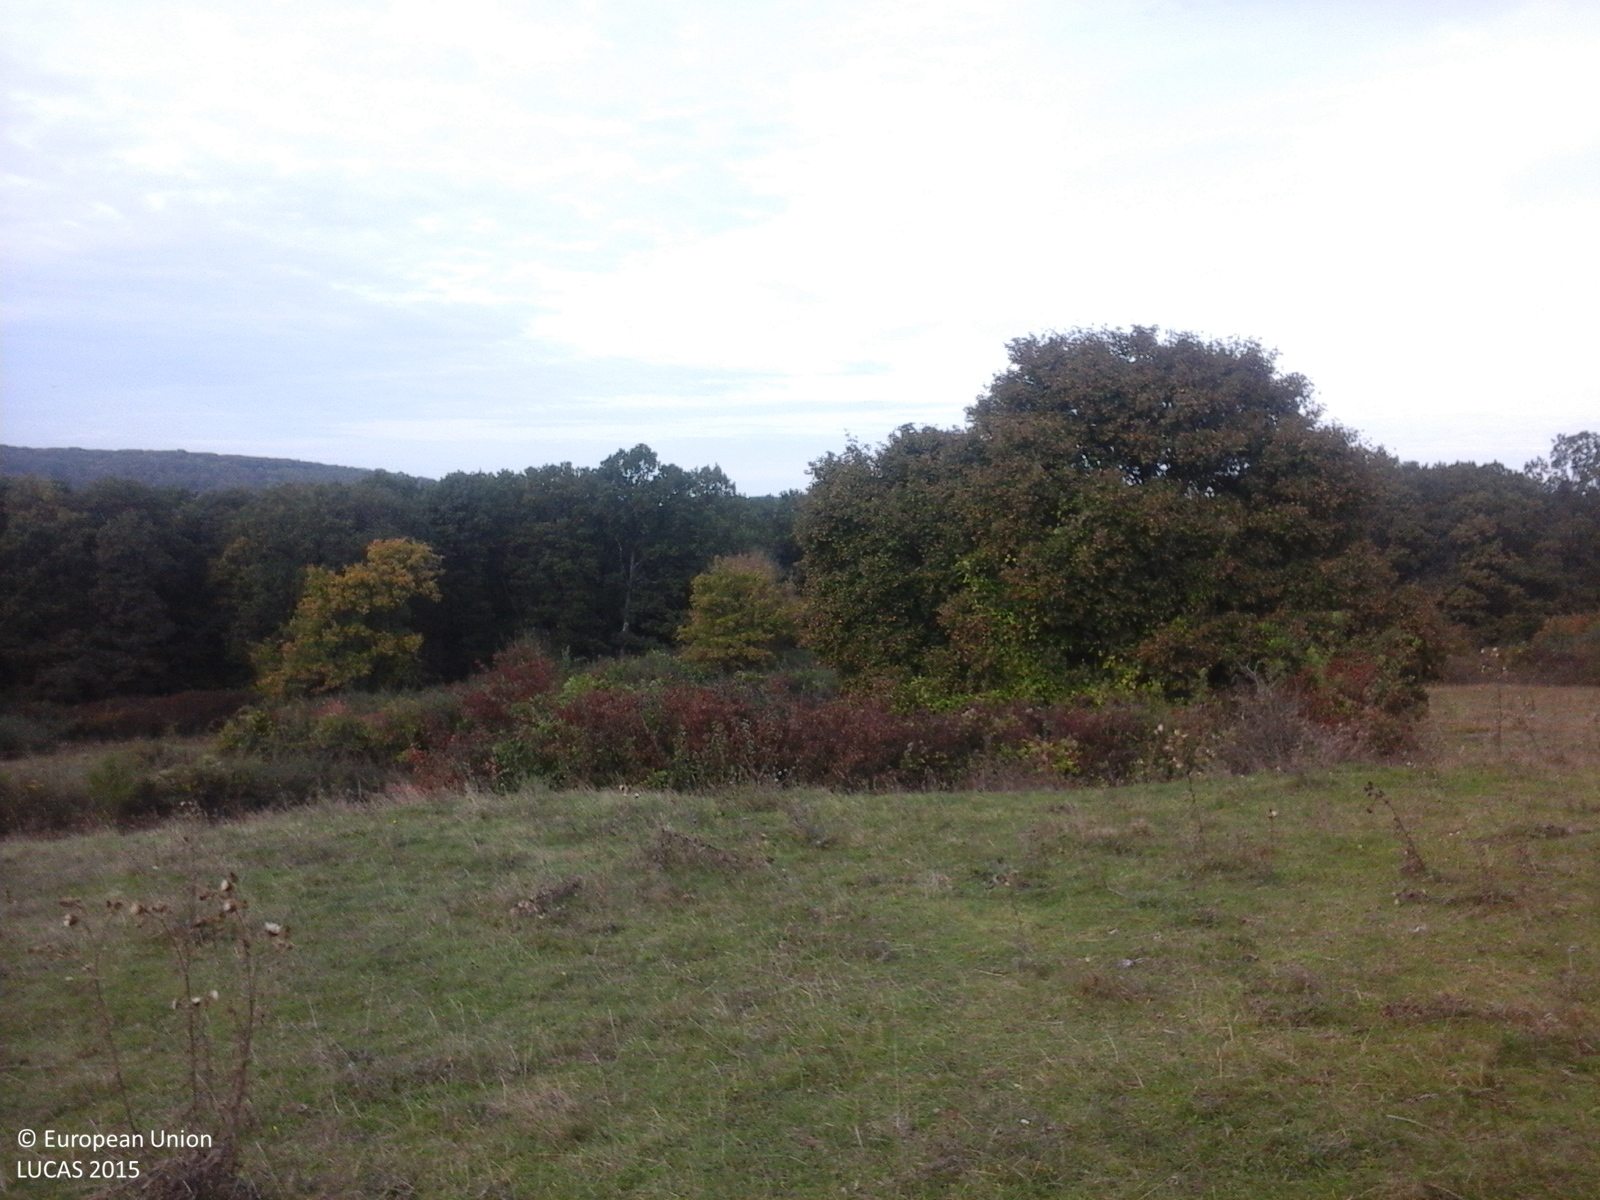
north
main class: Grassland
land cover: Spontaneously vegetated surfaces
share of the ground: > 75 %
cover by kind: herbaceous plants 100 %
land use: Agriculture (excluding fallow land and kitchen gardens)
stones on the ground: < 10 %
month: October
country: RO
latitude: 46.0733
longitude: 24.8699
